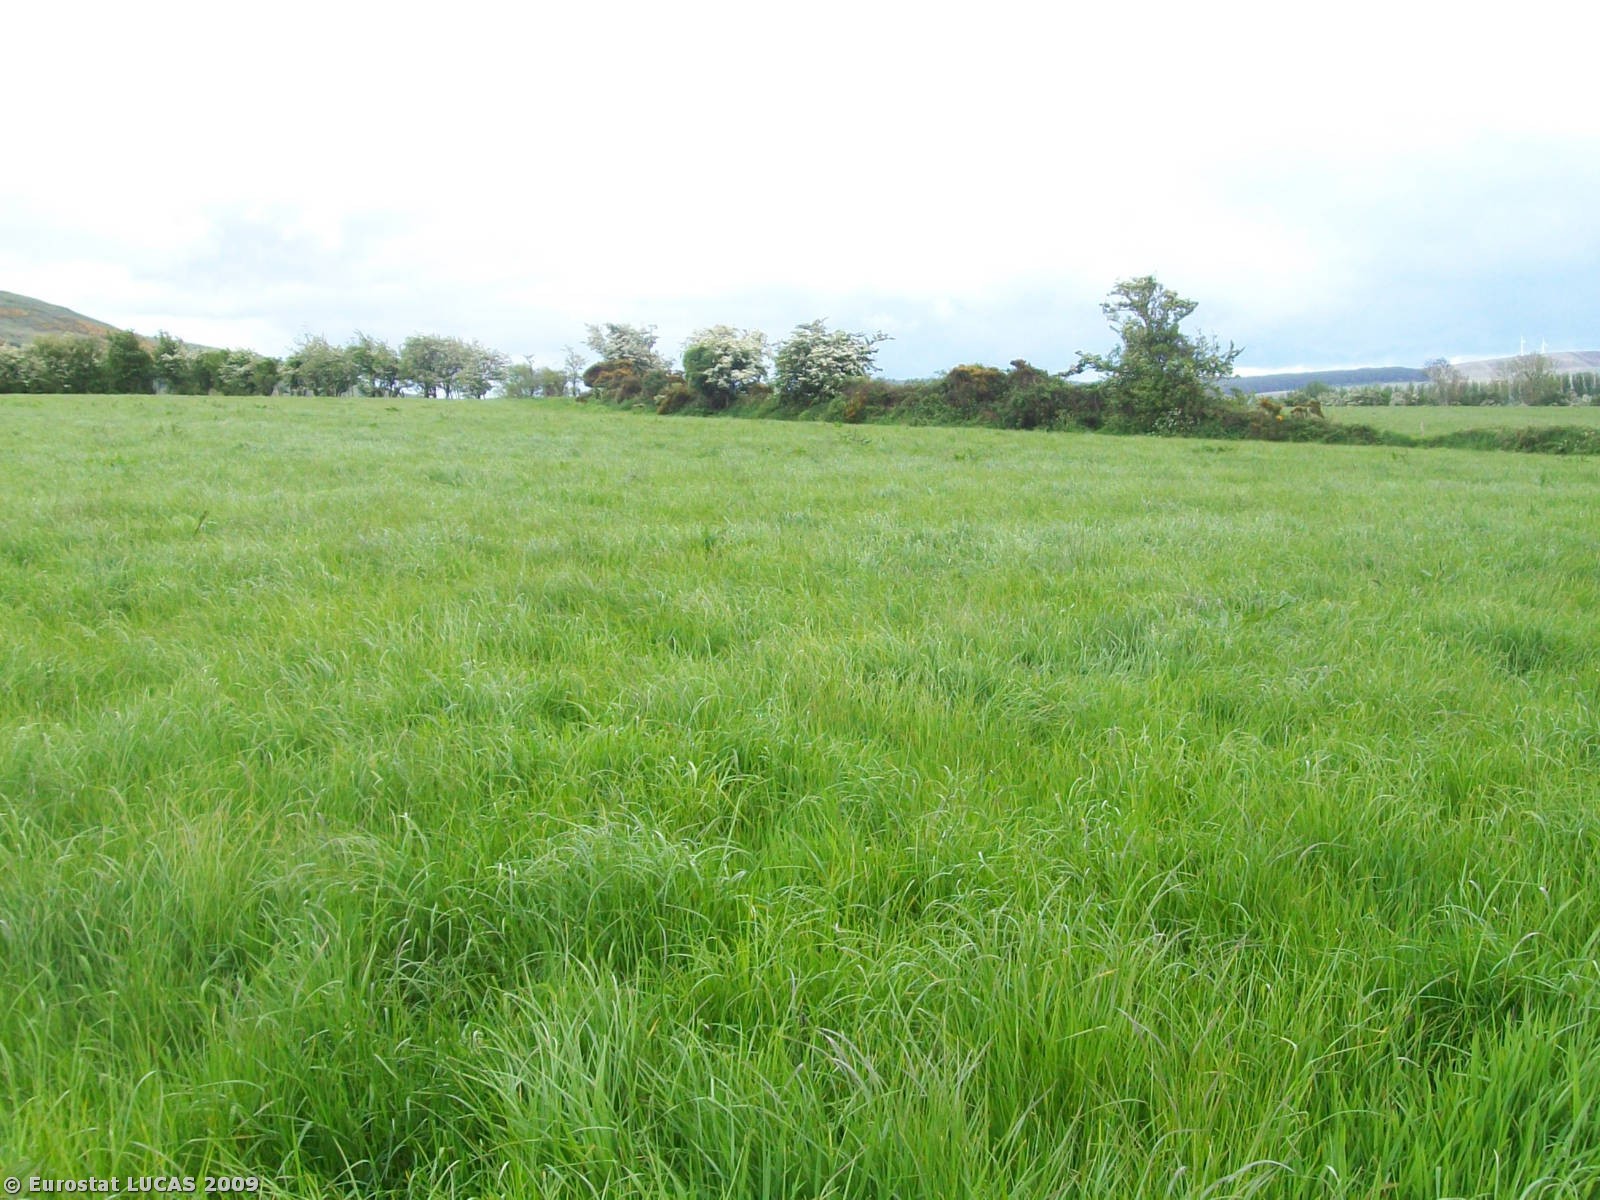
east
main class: Grassland
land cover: Grassland without tree/shrub cover
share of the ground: > 75 %
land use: Agriculture (excluding fallow land and kitchen gardens)
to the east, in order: Grassland without tree/shrub cover; Fences; Abandoned hedges; Grassland without tree/shrub cover
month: May
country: GB
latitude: 55.0541
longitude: -6.9001
